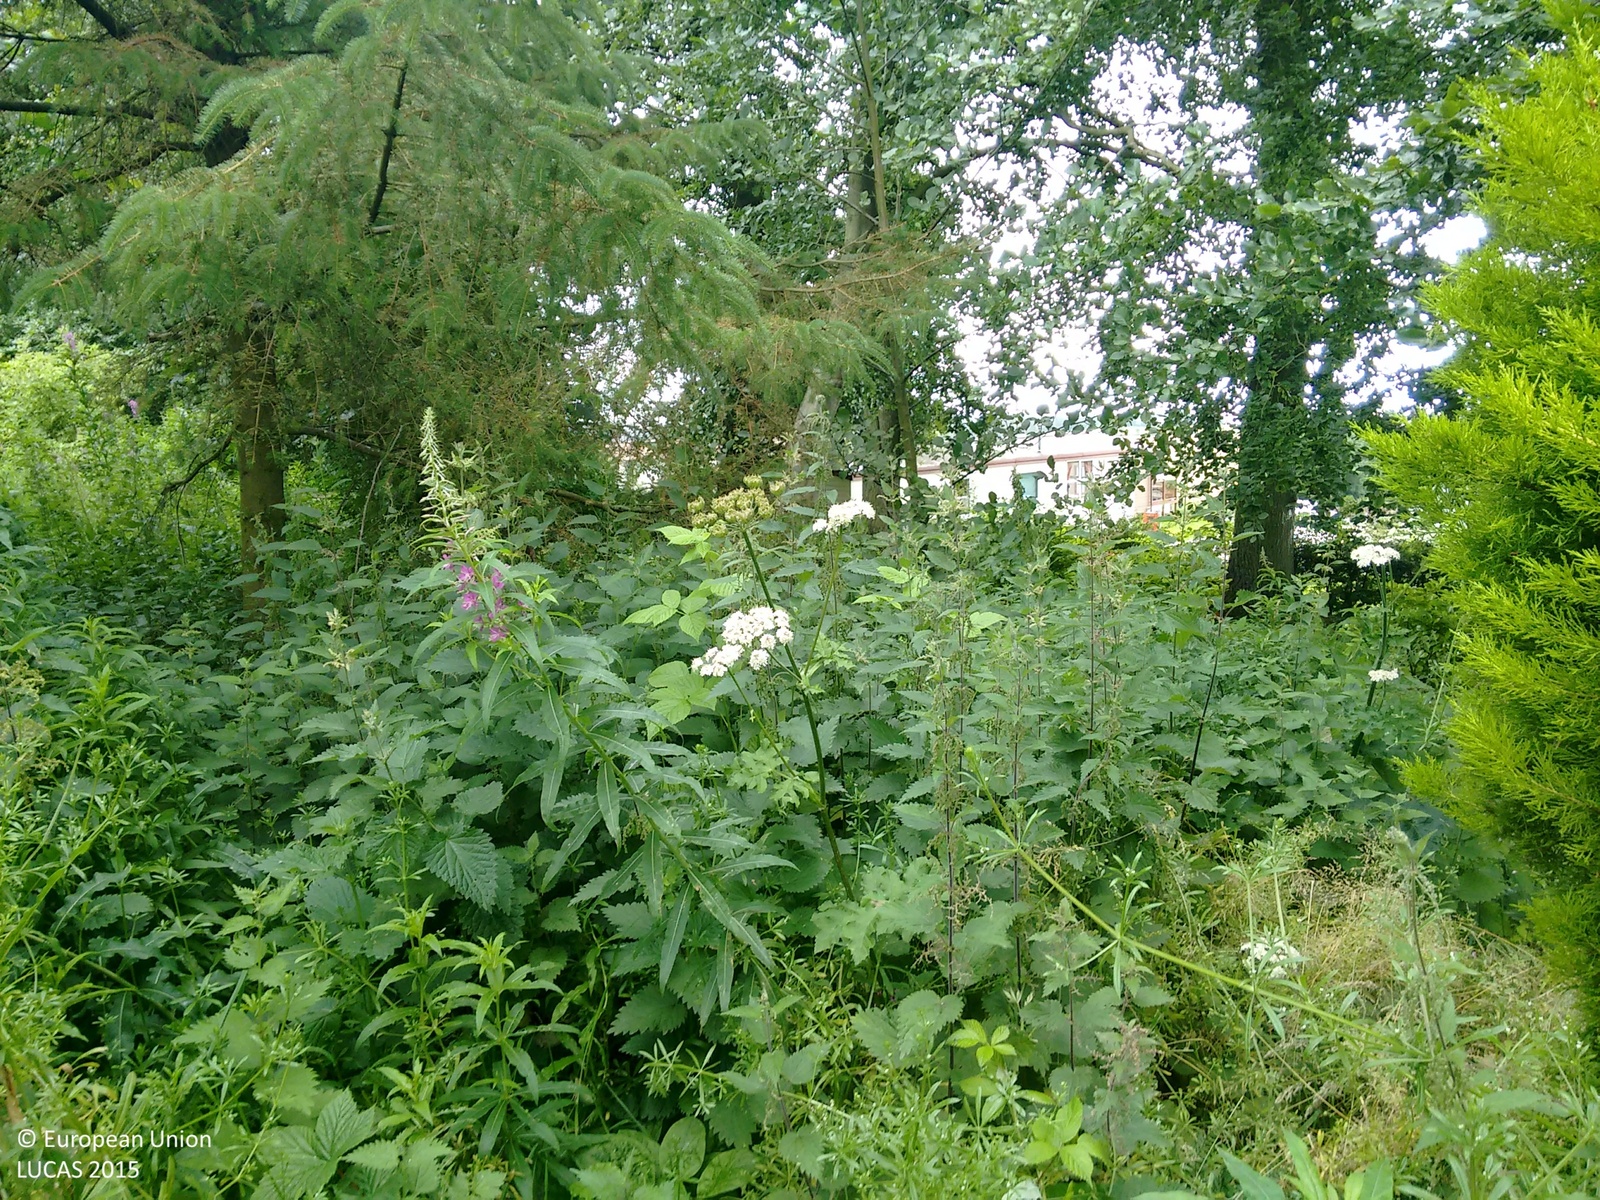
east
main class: Grassland
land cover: Grassland without tree/shrub cover
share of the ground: > 75 %
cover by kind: herbaceous plants 100 %
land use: Agriculture (excluding fallow land and kitchen gardens)
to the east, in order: Grassland without tree/shrub cover; Fences; Abandoned hedges; Ditches and canals; Broadleaved woodland; Tracks; Broadleaved woodland; Artificial constructions in urban areas
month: August
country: GB
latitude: 56.2320
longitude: -3.0210
